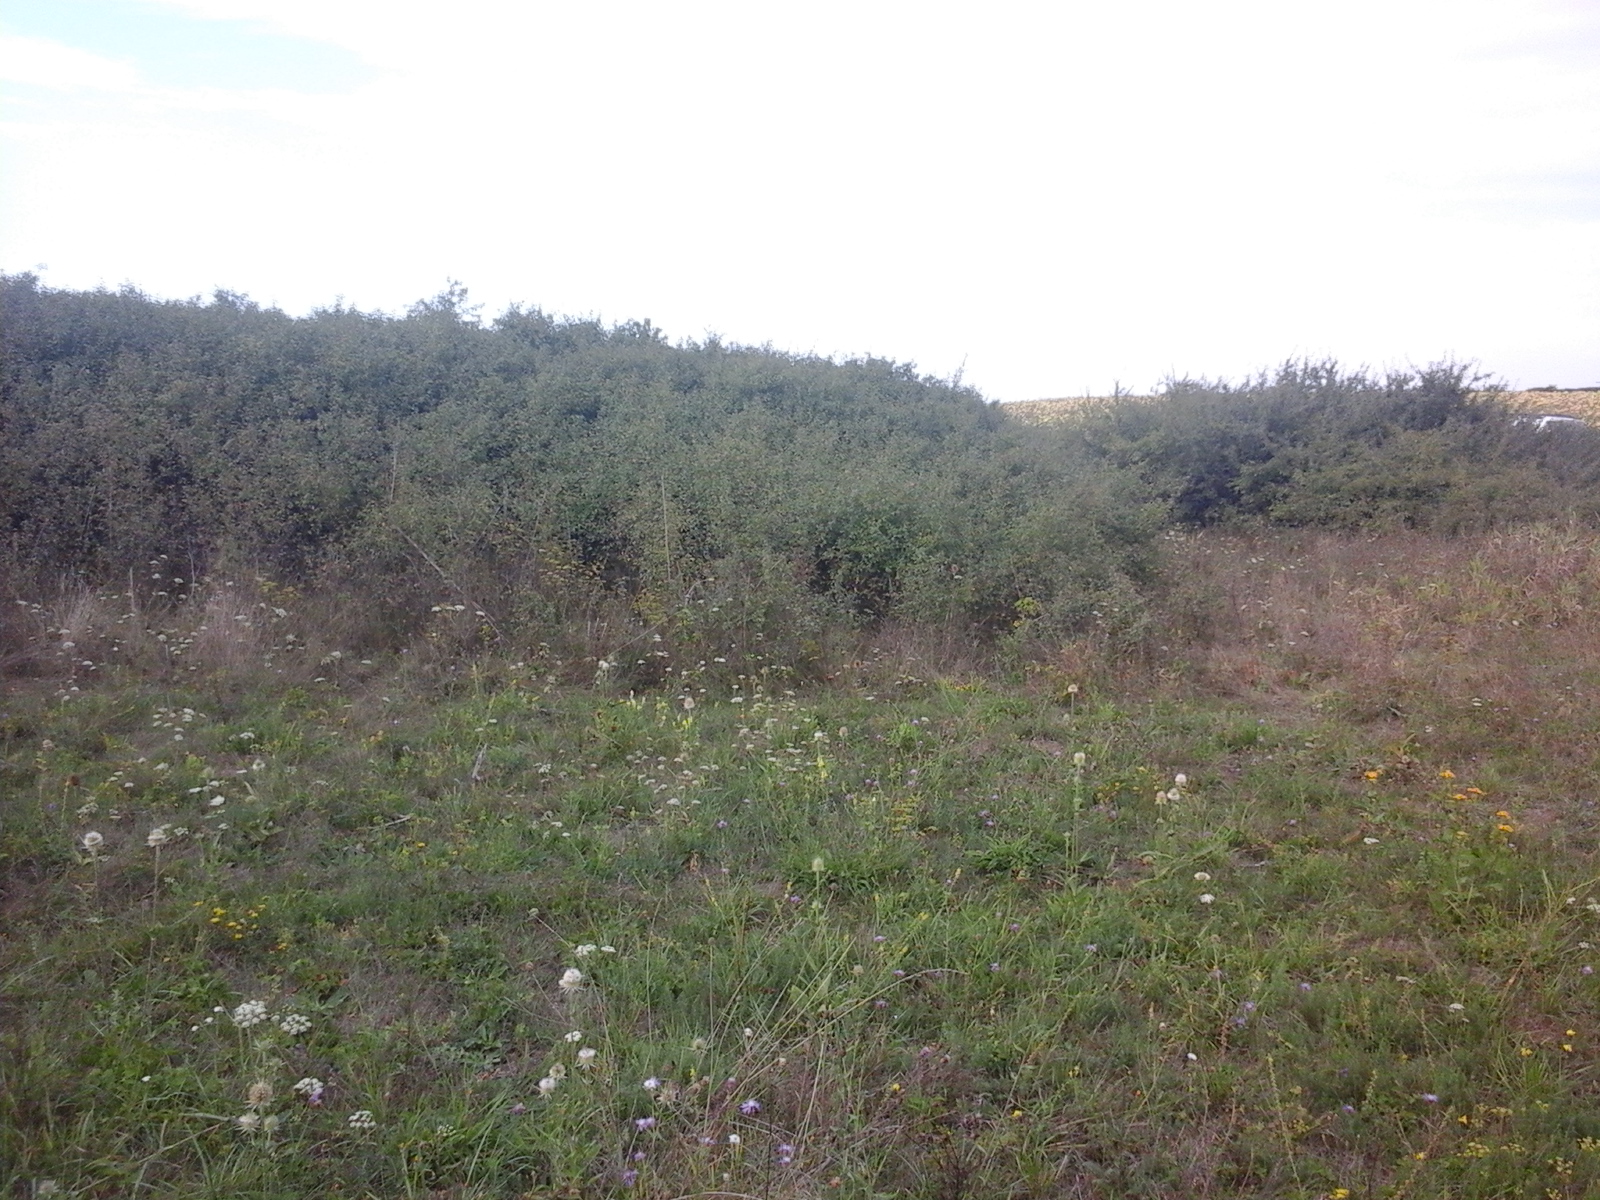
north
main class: Grassland
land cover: Grassland without tree/shrub cover
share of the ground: > 75 %
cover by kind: herbaceous plants 100 %
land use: Agriculture (excluding fallow land and kitchen gardens)
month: August
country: RO
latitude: 46.7366
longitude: 21.5961
